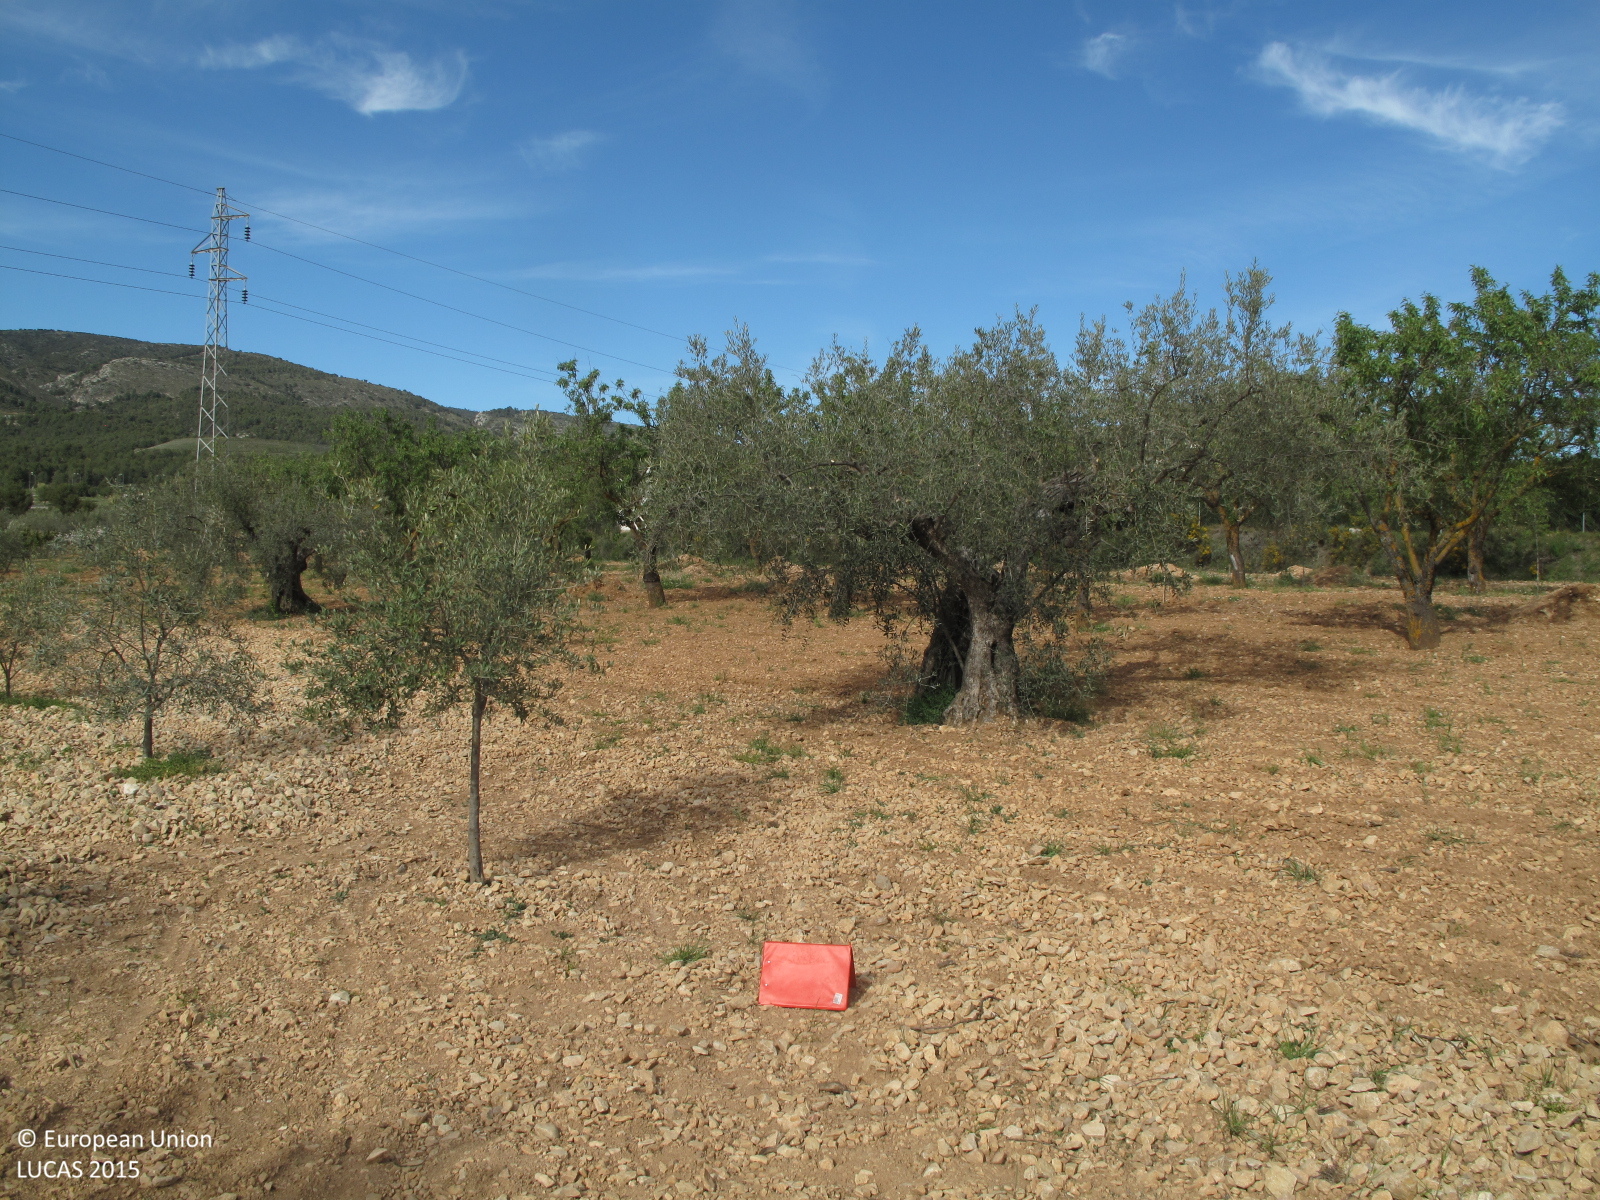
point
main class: Cropland
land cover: Olive groves
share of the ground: 10 - 25 %
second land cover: Other bare soil
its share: > 75 %
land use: Agriculture (excluding fallow land and kitchen gardens)
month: April
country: ES
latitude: 38.6211
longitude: -0.5441
